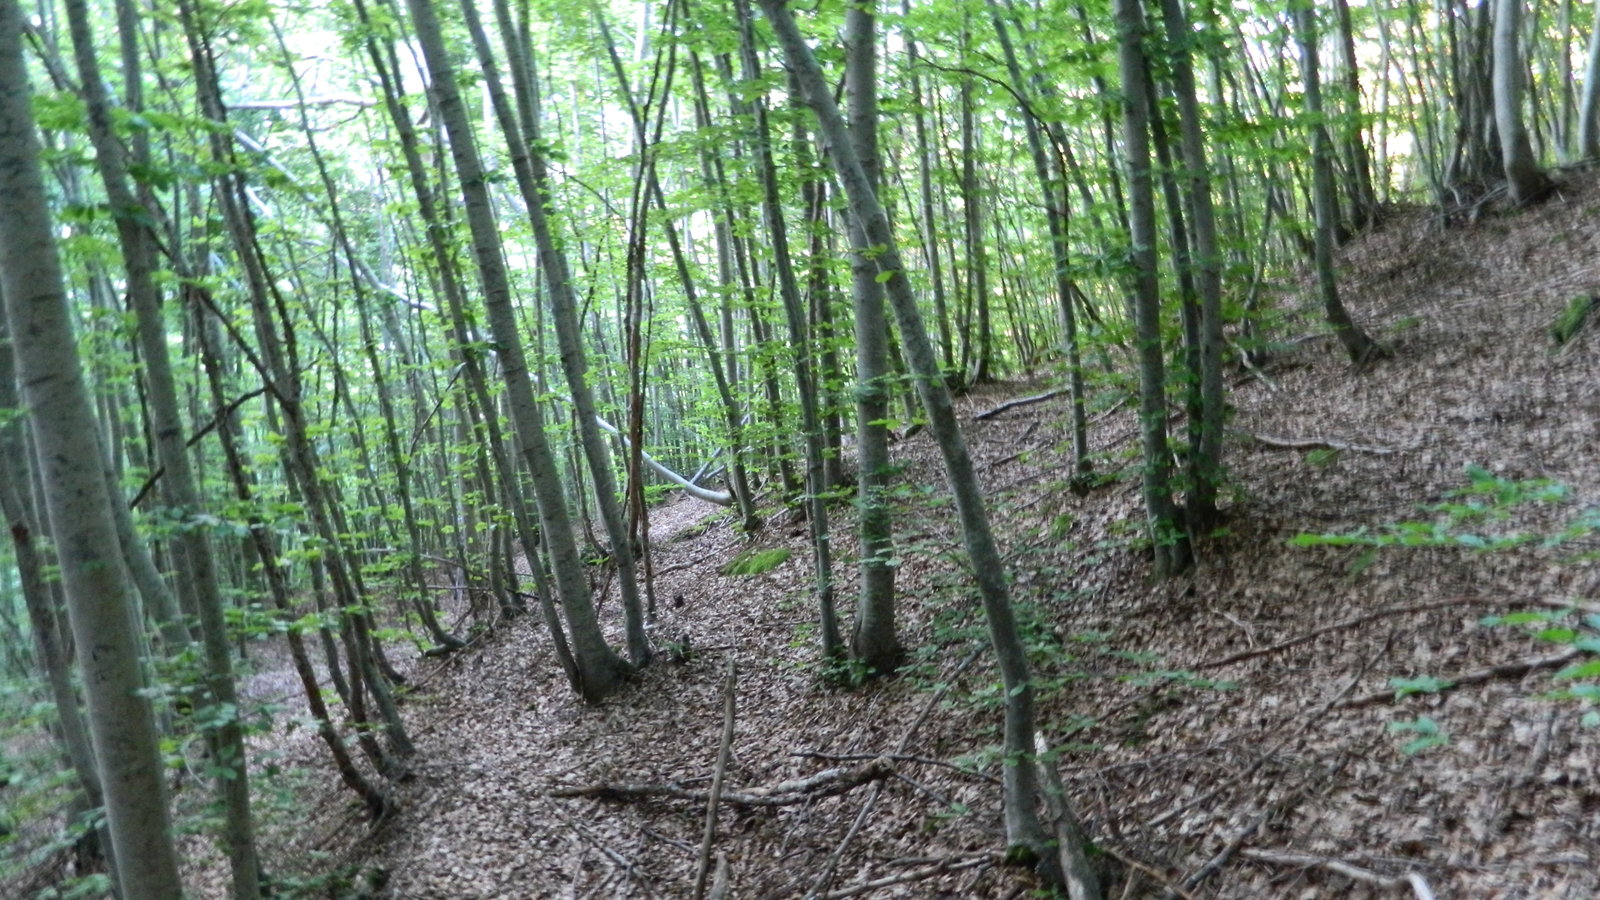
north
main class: Woodland
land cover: Broadleaved woodland
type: beech forest
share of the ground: > 75 %
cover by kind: broadleaved forest trees 100 %
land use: Forestry
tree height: > 5 m
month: July
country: BG
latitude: 41.6191
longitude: 24.8935
